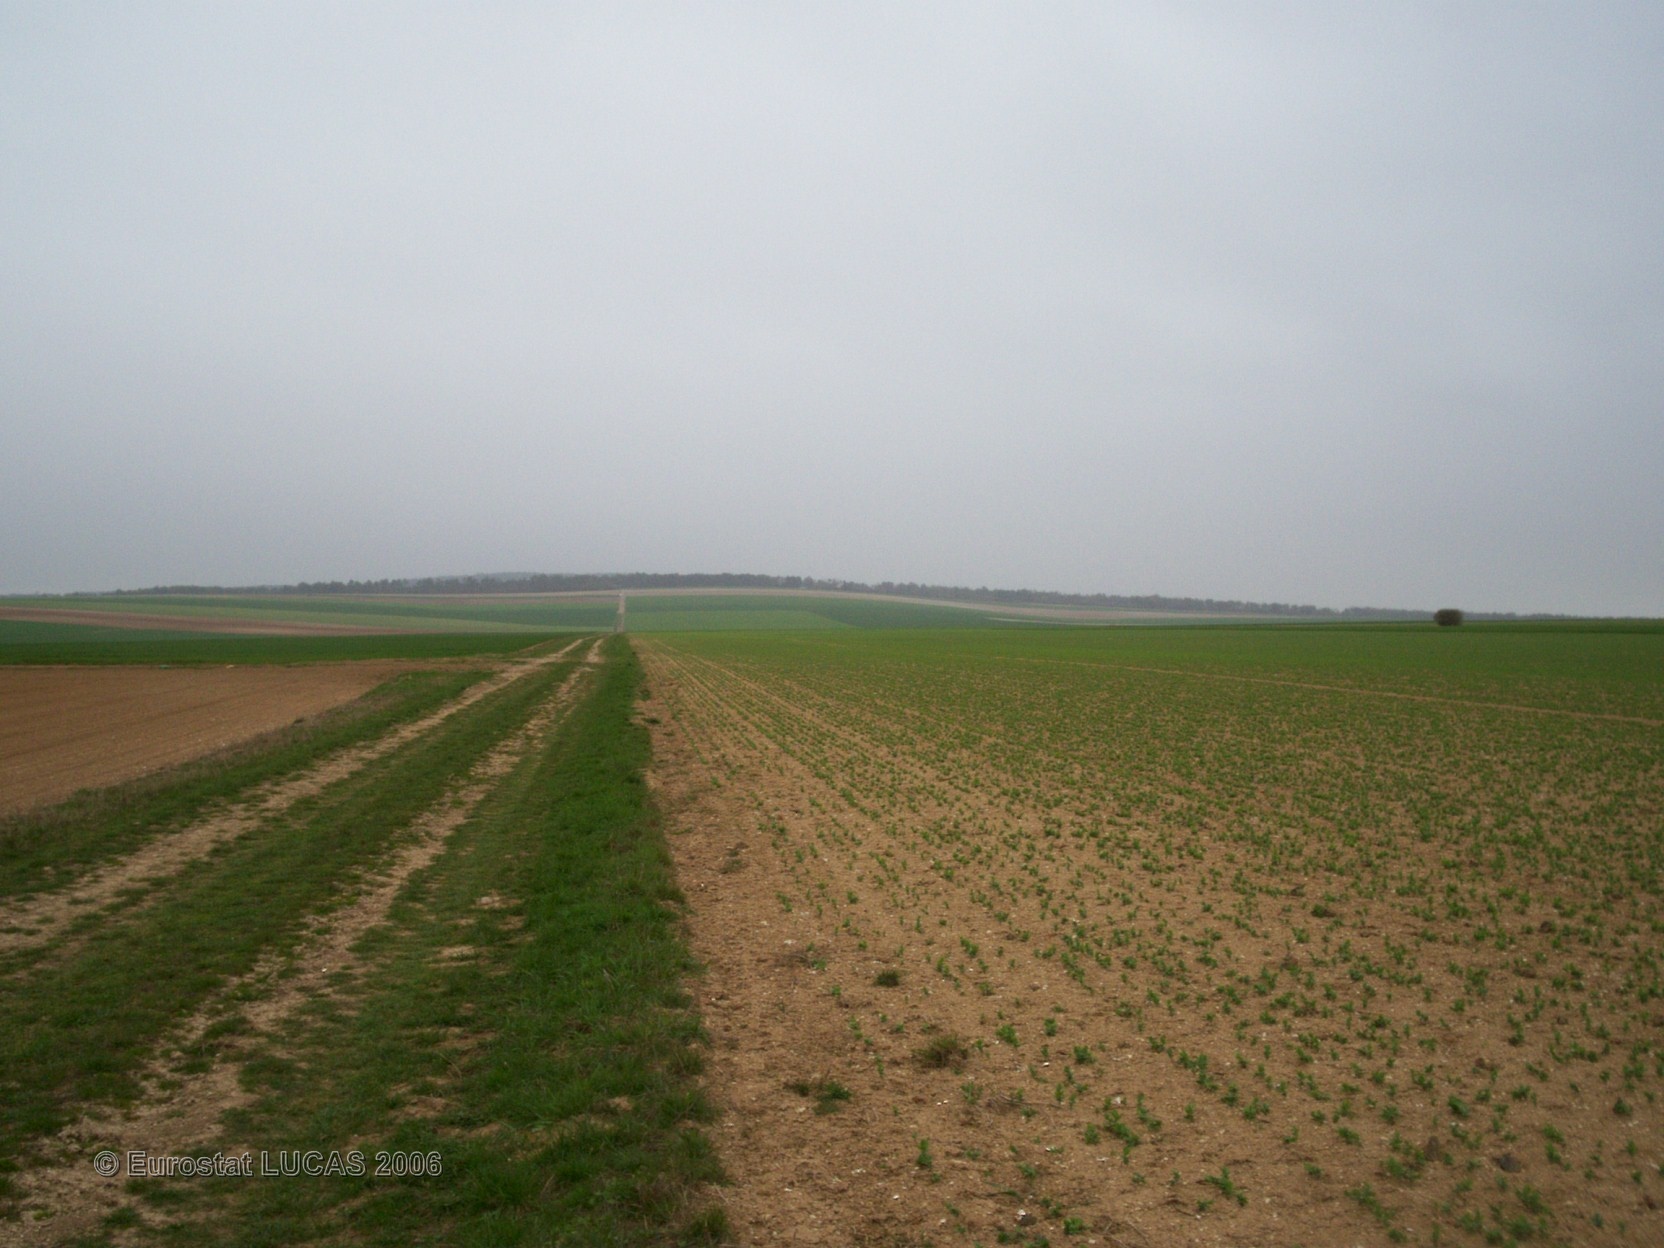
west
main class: Cropland
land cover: Dry pulses
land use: Agriculture (excluding fallow land and kitchen gardens)
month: April
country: FR
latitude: 49.2523
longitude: 4.3770
